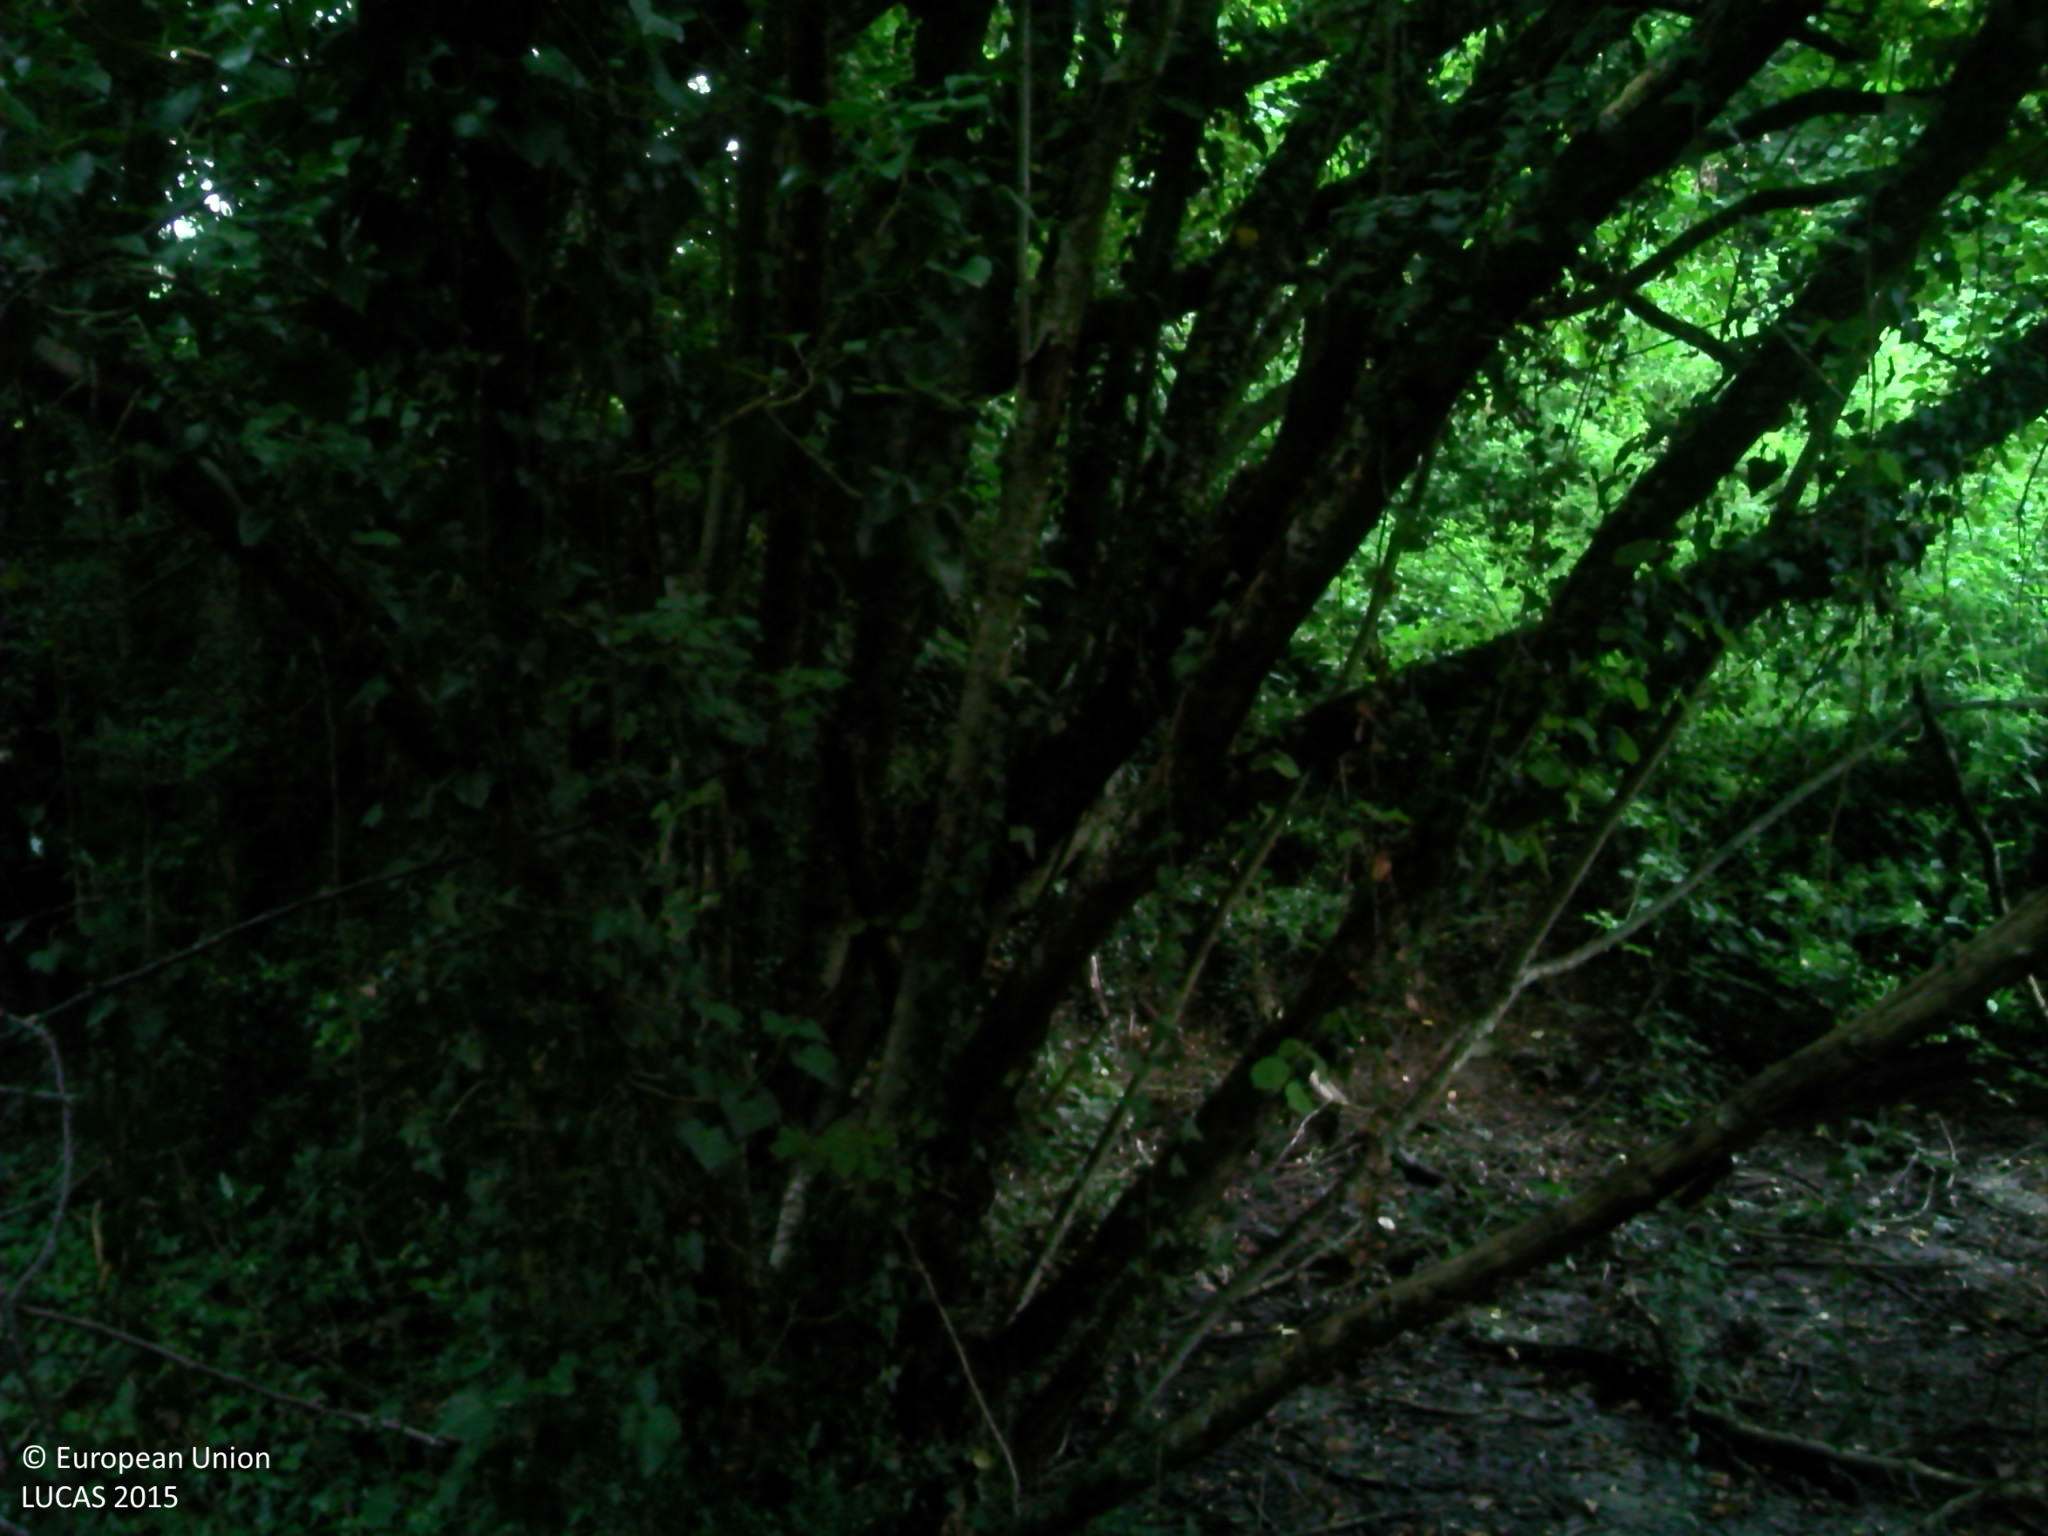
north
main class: Woodland
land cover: Broadleaved woodland
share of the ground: > 75 %
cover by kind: broadleaved forest trees 75 %, herbaceous plants 10 %, lichens and mosses 10 %, shrubs 5 %
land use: Forestry
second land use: Agriculture (excluding fallow land and kitchen gardens)
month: August
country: FR
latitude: 46.3742
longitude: 2.2069
